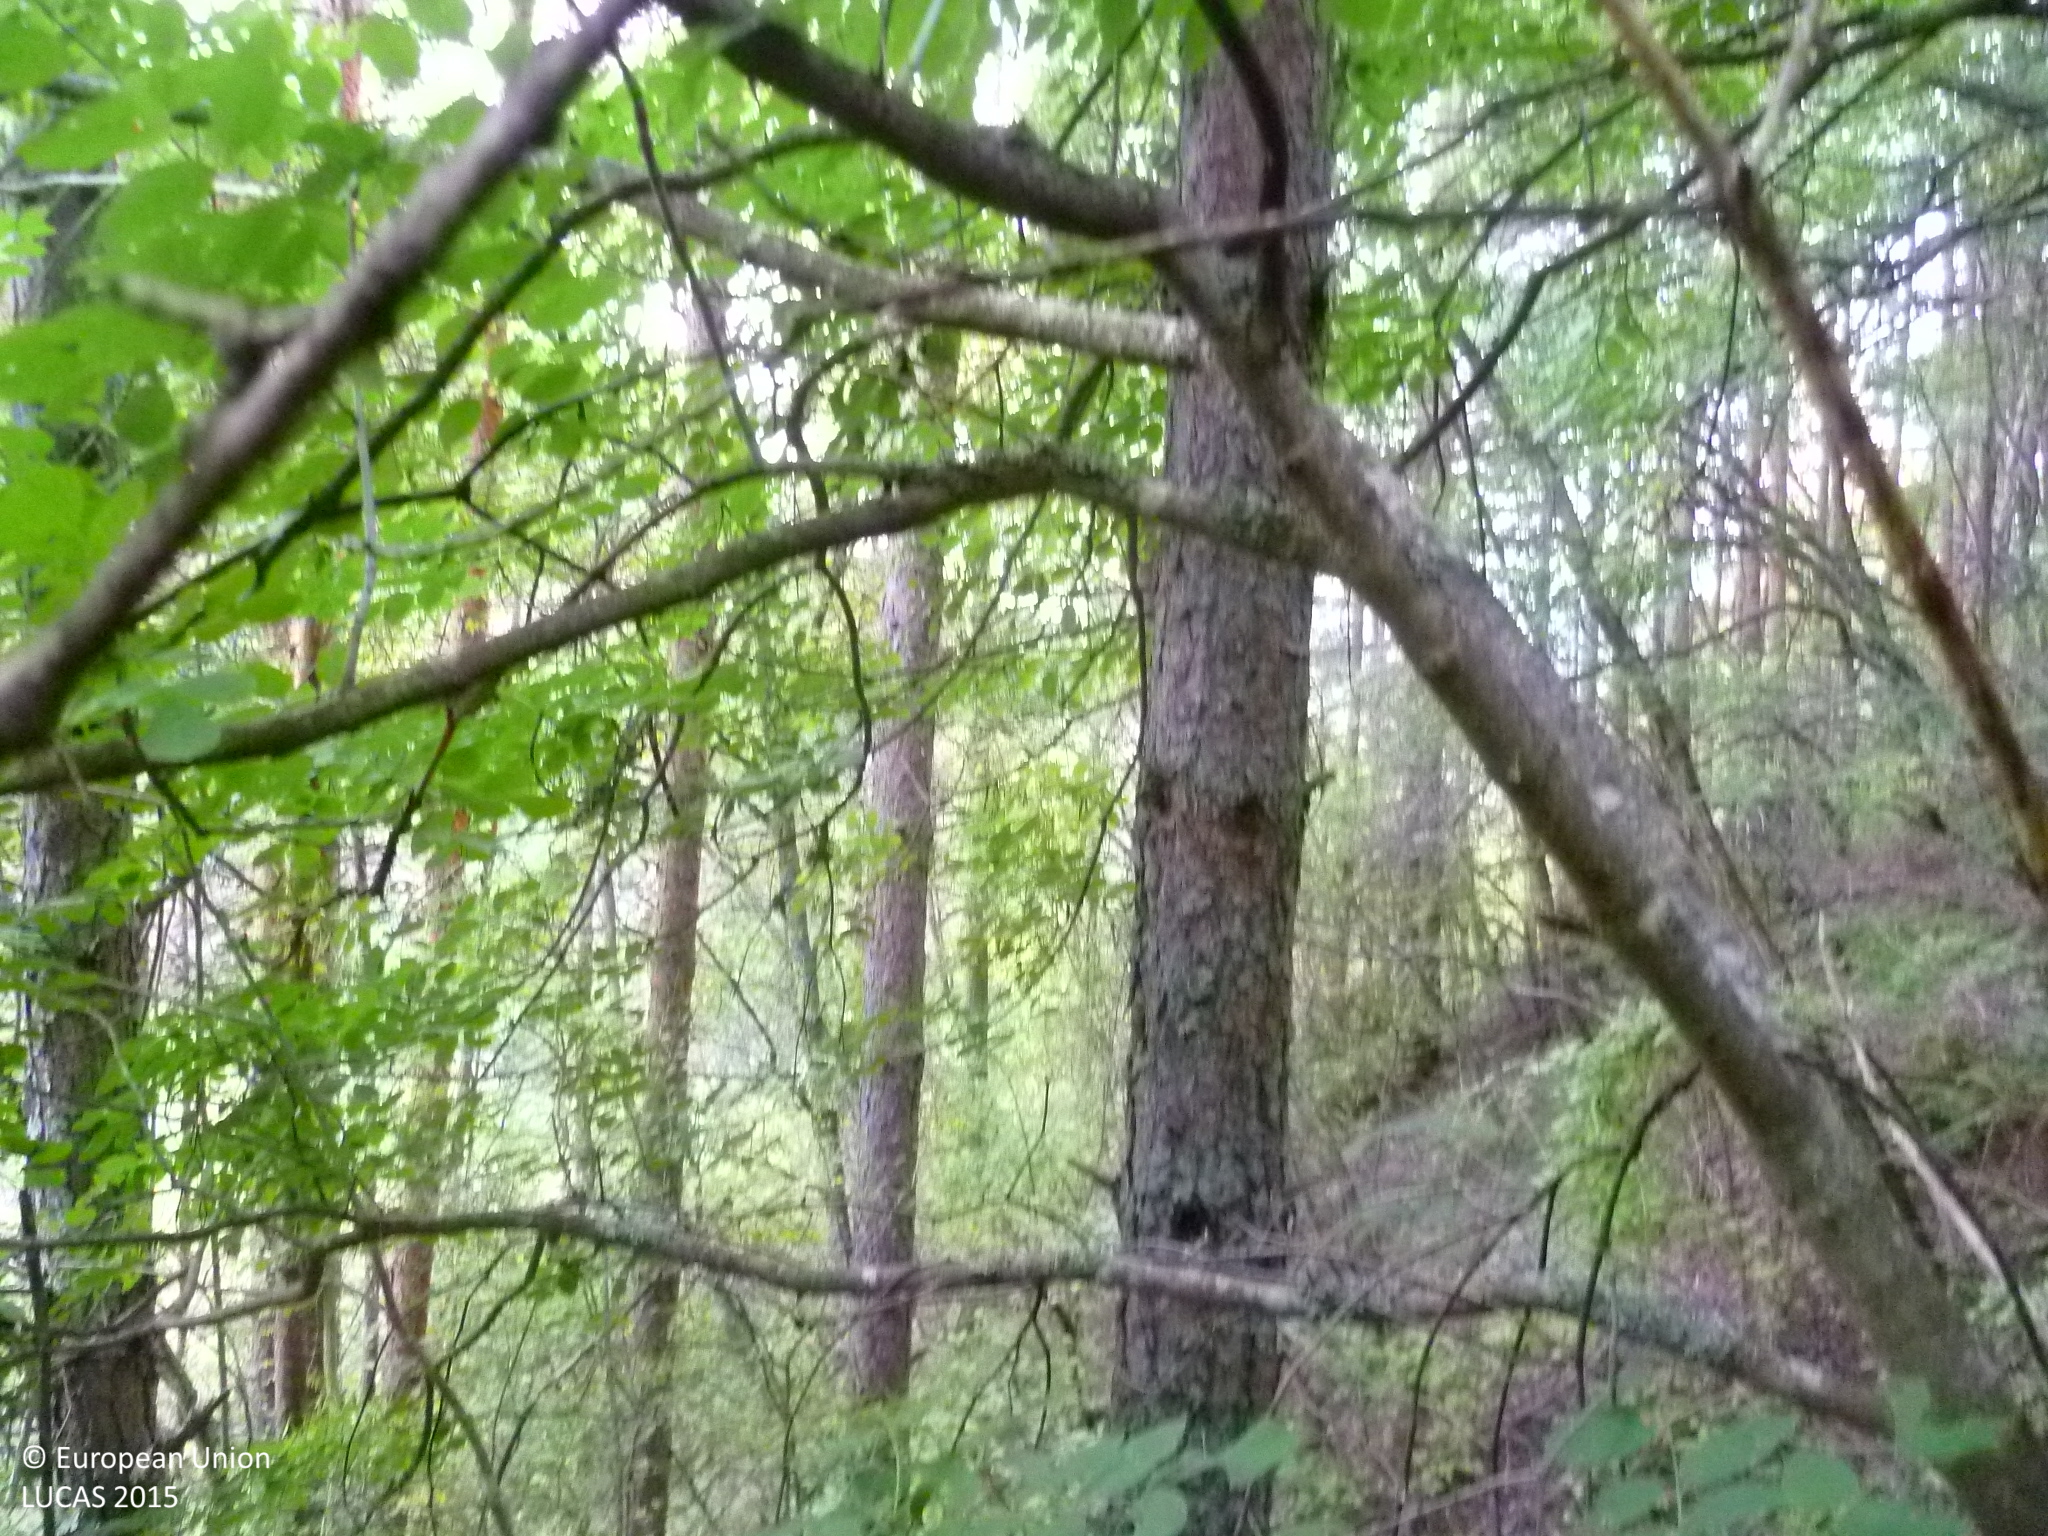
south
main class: Woodland
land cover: Pine dominated mixed woodland
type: mesophytic deciduous forest
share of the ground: > 75 %
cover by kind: coniferous forest trees 60 %, broadleaved forest trees 20 %, unconsolidated bare surface 20 %
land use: Forestry
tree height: > 5 m
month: October
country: BG
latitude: 42.7224
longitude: 22.7391
